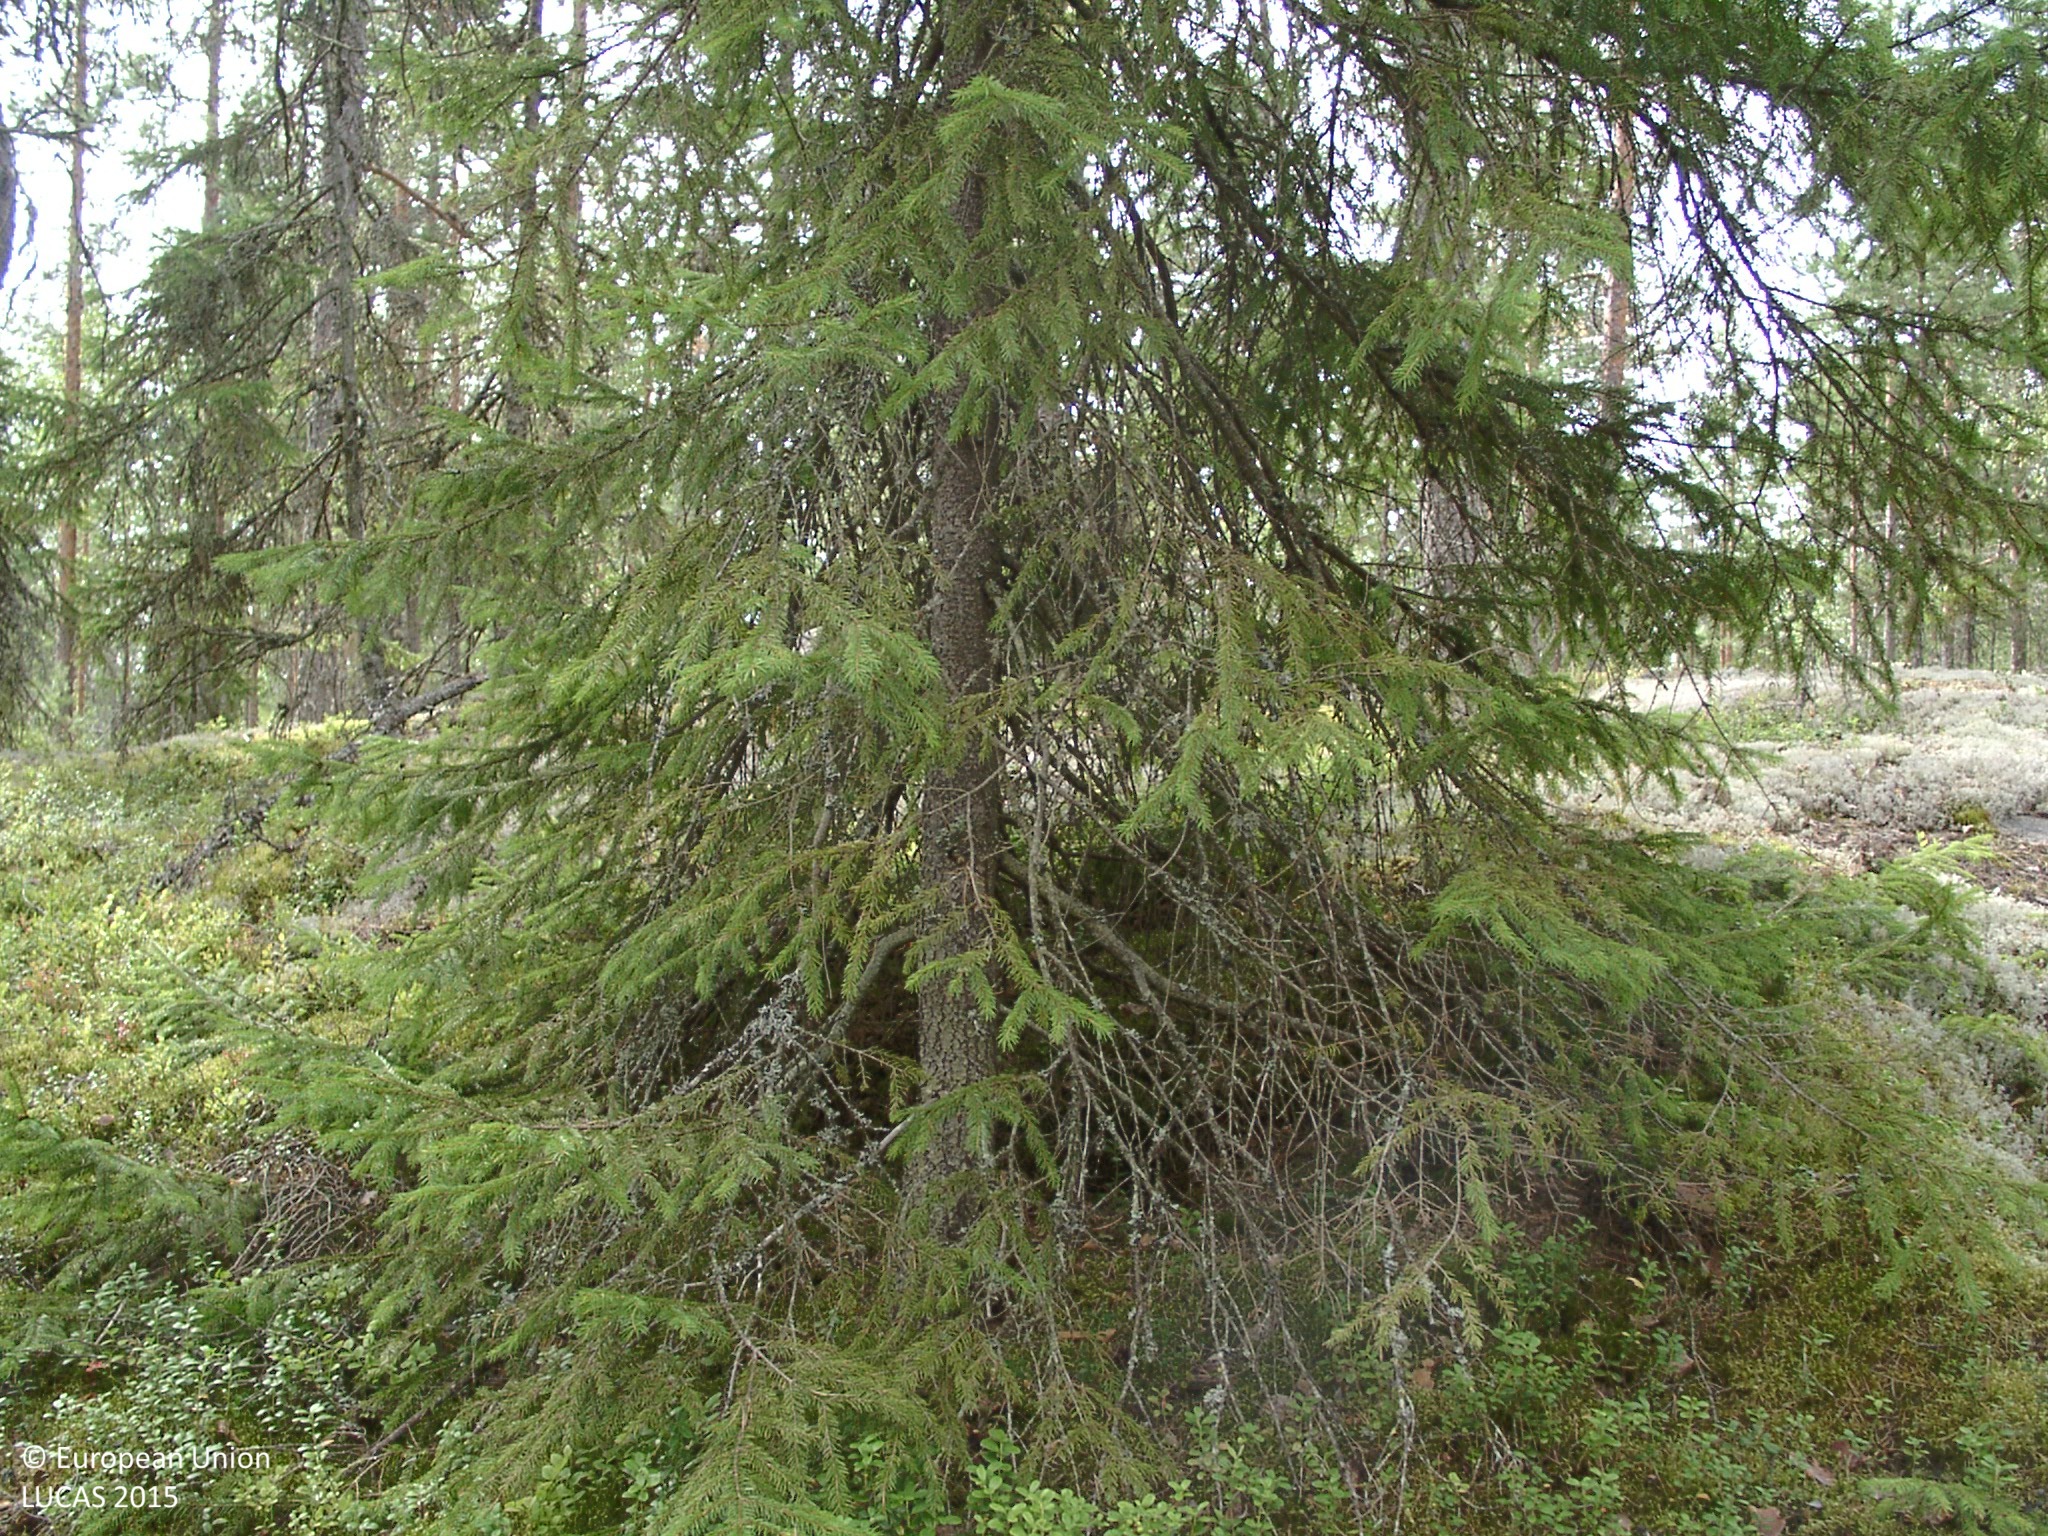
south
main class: Woodland
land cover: Other mixed woodland
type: boreal forest
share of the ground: 50 - 75 %
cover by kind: coniferous forest trees 40 %, lichens and mosses 25 %, shrubs 20 %, broadleaved forest trees 15 %
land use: Forestry
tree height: > 5 m
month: August
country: FI
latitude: 61.8604
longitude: 25.2996
